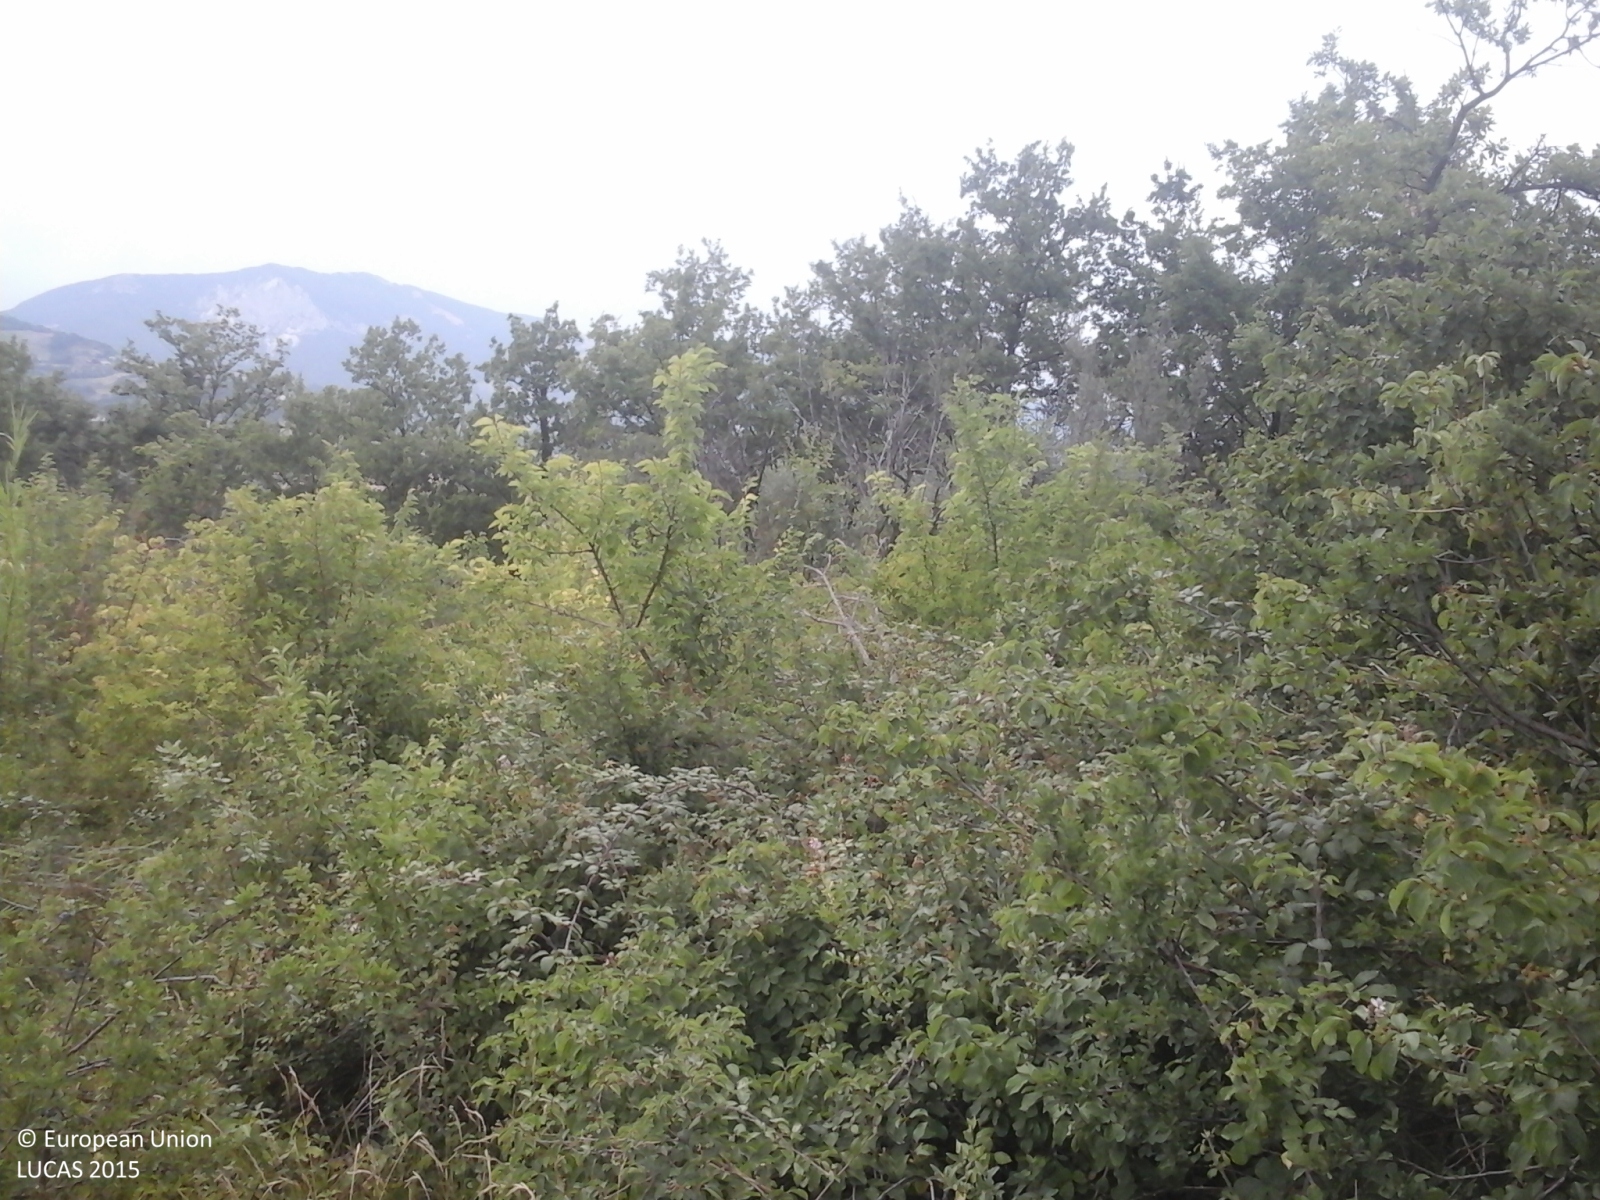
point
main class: Woodland
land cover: Broadleaved woodland
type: thermophilous deciduous forest
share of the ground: > 75 %
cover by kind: broadleaved forest trees 80 %, shrubs 10 %, herbaceous plants 10 %
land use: Semi-natural and natural areas not in use
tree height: > 5 m
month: July
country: IT
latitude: 42.2714
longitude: 13.9039
